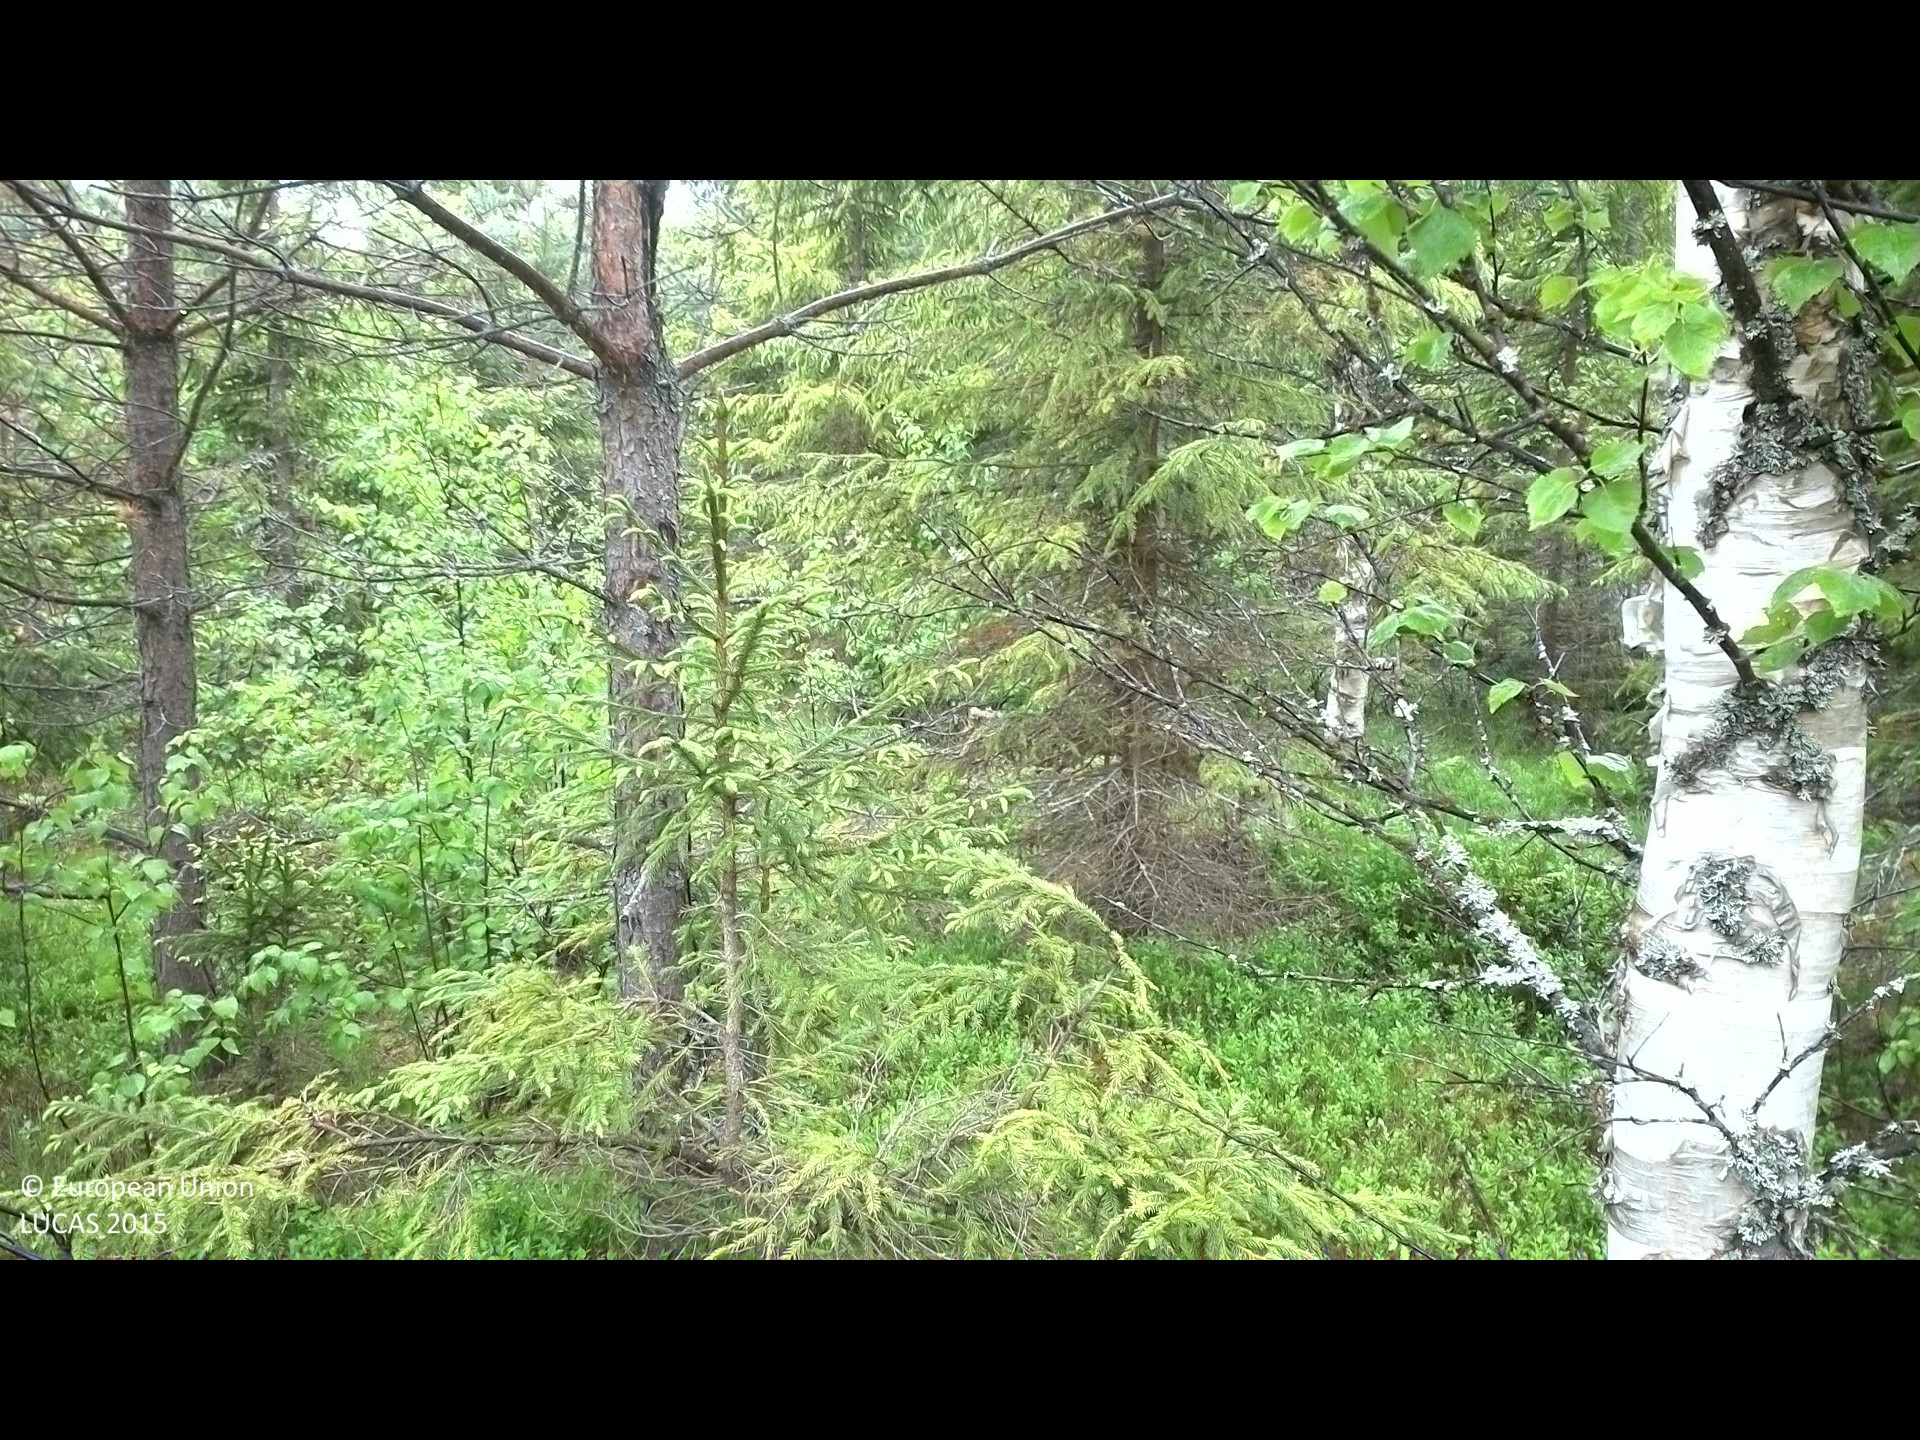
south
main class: Woodland
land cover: Spruce dominated mixed woodland
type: boreal forest
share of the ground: 25 - 50 %
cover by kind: shrubs 50 %, coniferous forest trees 25 %, broadleaved forest trees 15 %, lichens and mosses 10 %
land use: Forestry
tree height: > 5 m
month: June
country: SE
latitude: 62.1532
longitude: 17.1395
